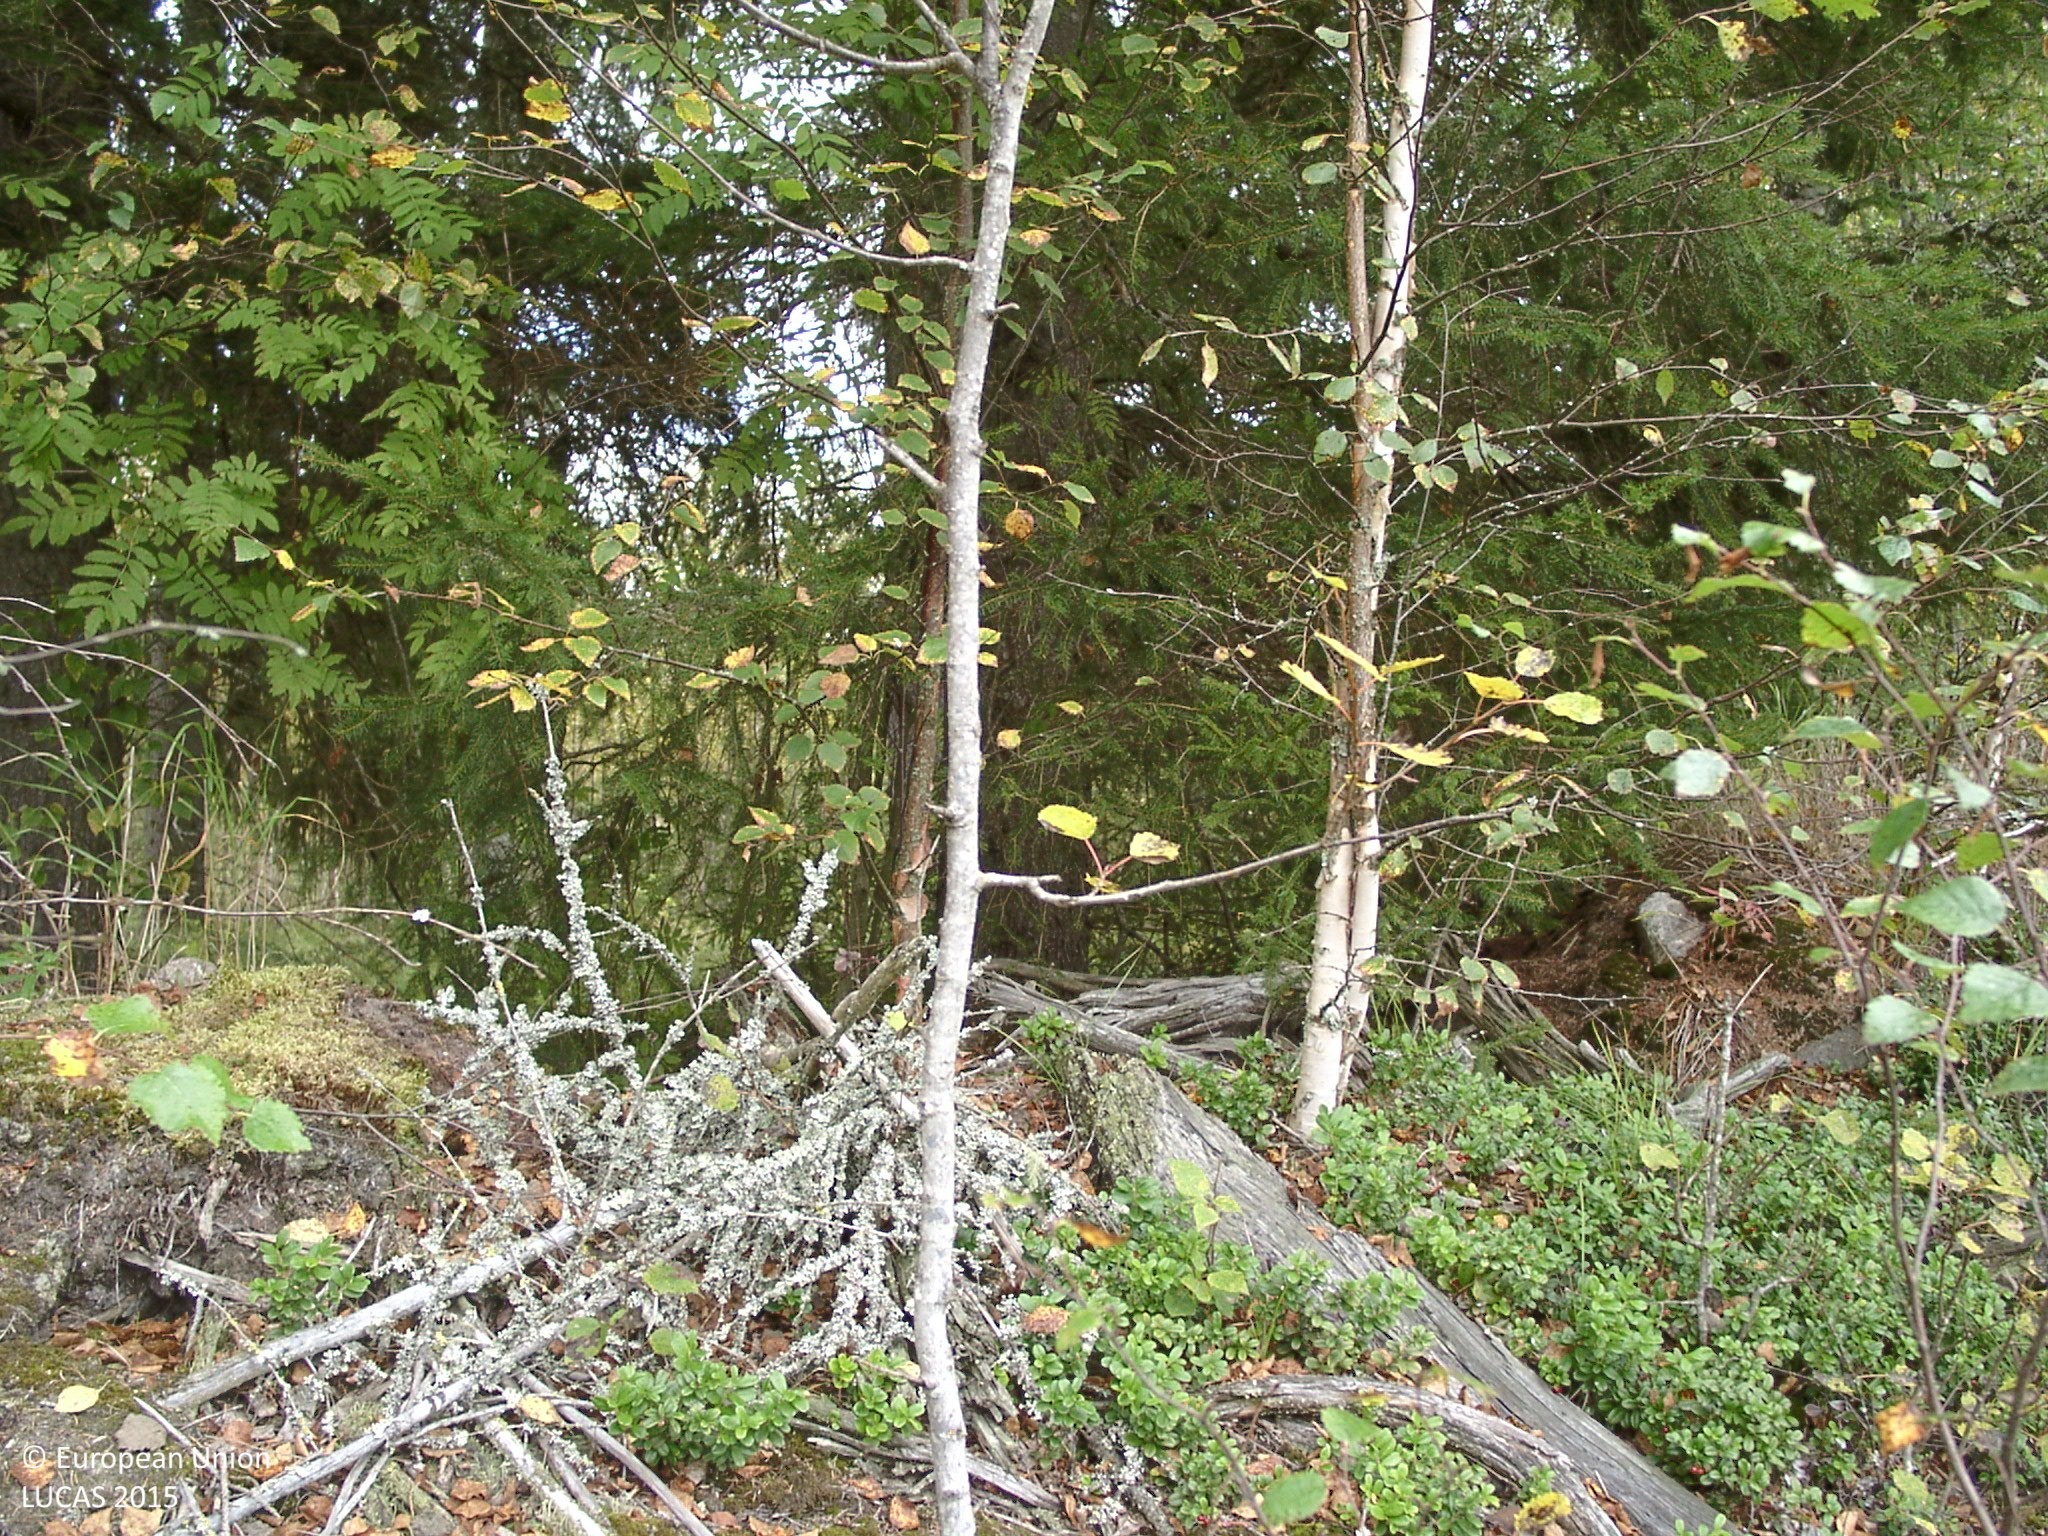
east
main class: Woodland
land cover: Spruce dominated mixed woodland
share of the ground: 50 - 75 %
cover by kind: coniferous forest trees 40 %, broadleaved forest trees 25 %, shrubs 25 %, herbaceous plants 5 %, lichens and mosses 5 %
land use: Forestry
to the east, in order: Ditches and canals; Spruce dominated mixed woodland; Broadleaved woodland; Spruce dominated coniferous woodland; Broadleaved woodland; Other mixed woodland
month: September
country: FI
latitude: 62.8764
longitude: 25.0999
